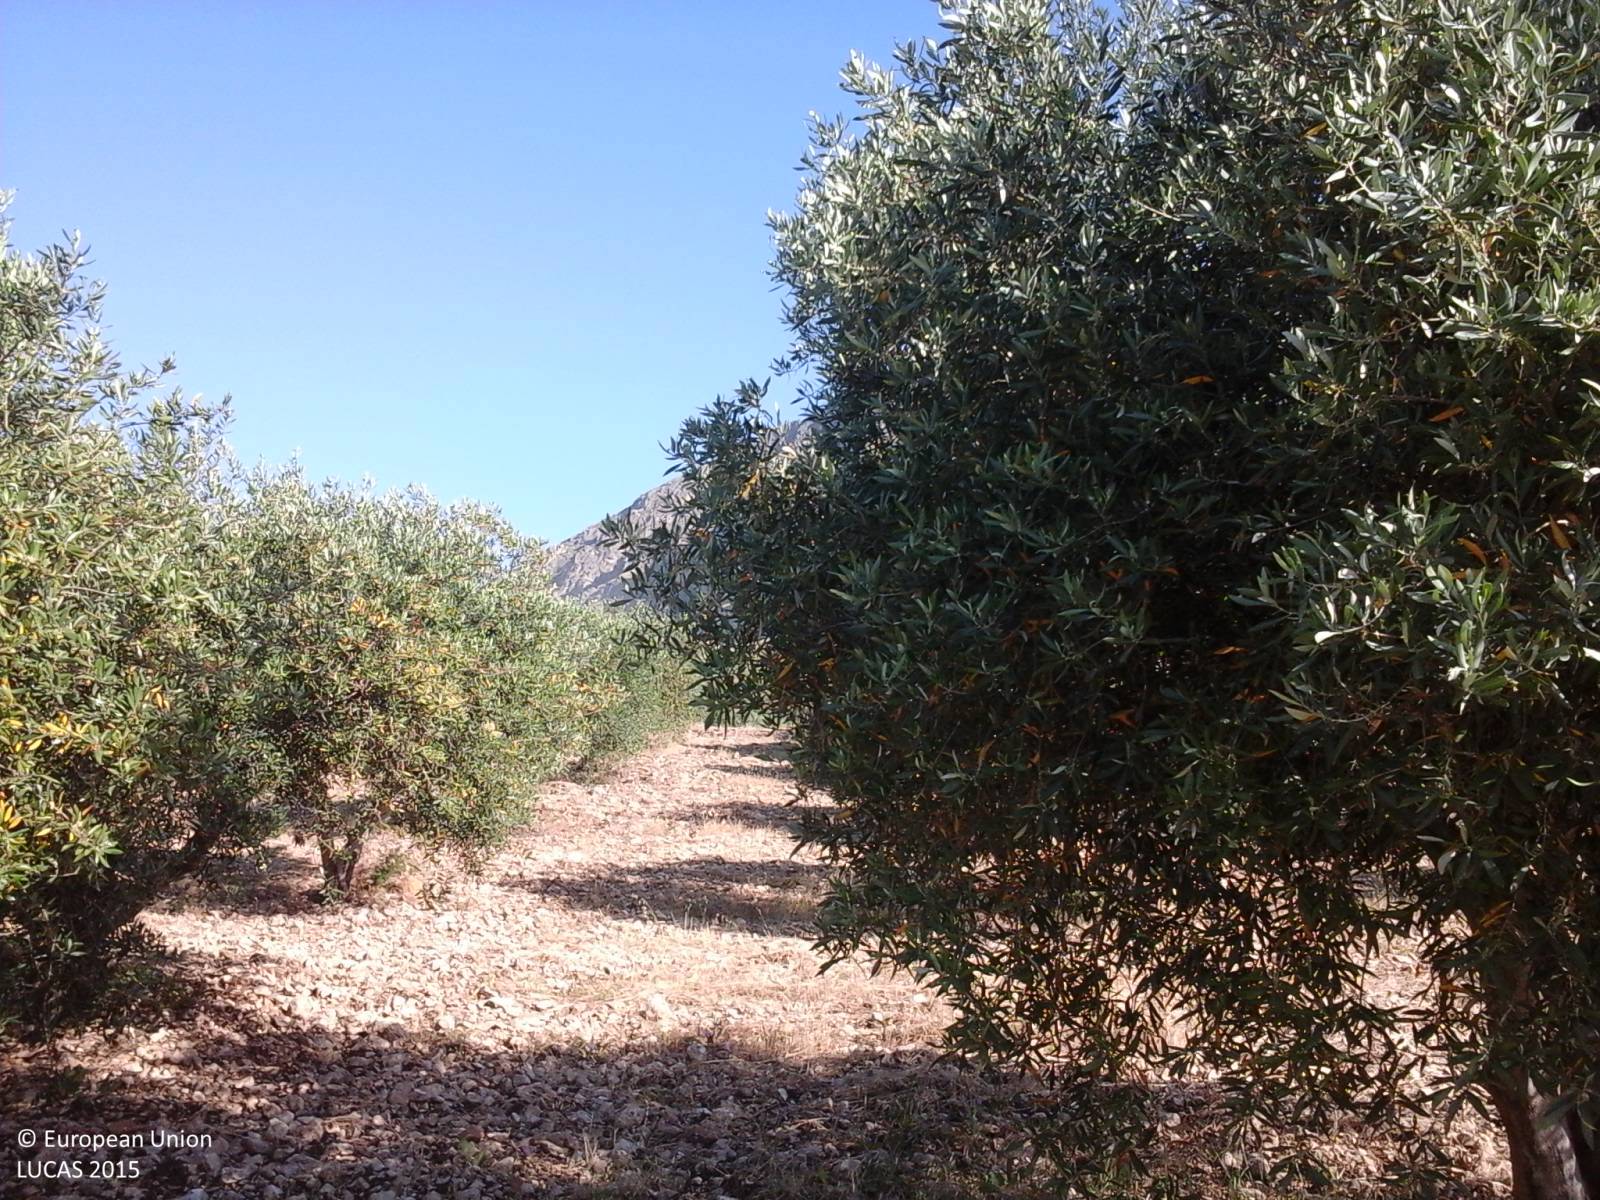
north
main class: Grassland
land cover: Grassland with sparse tree/shrub cover
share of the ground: > 75 %
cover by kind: herbaceous plants 95 %, broadleaved forest trees 5 %
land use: Abandoned areas
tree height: > 5 m
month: June
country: IT
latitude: 37.9859
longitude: 13.1540
